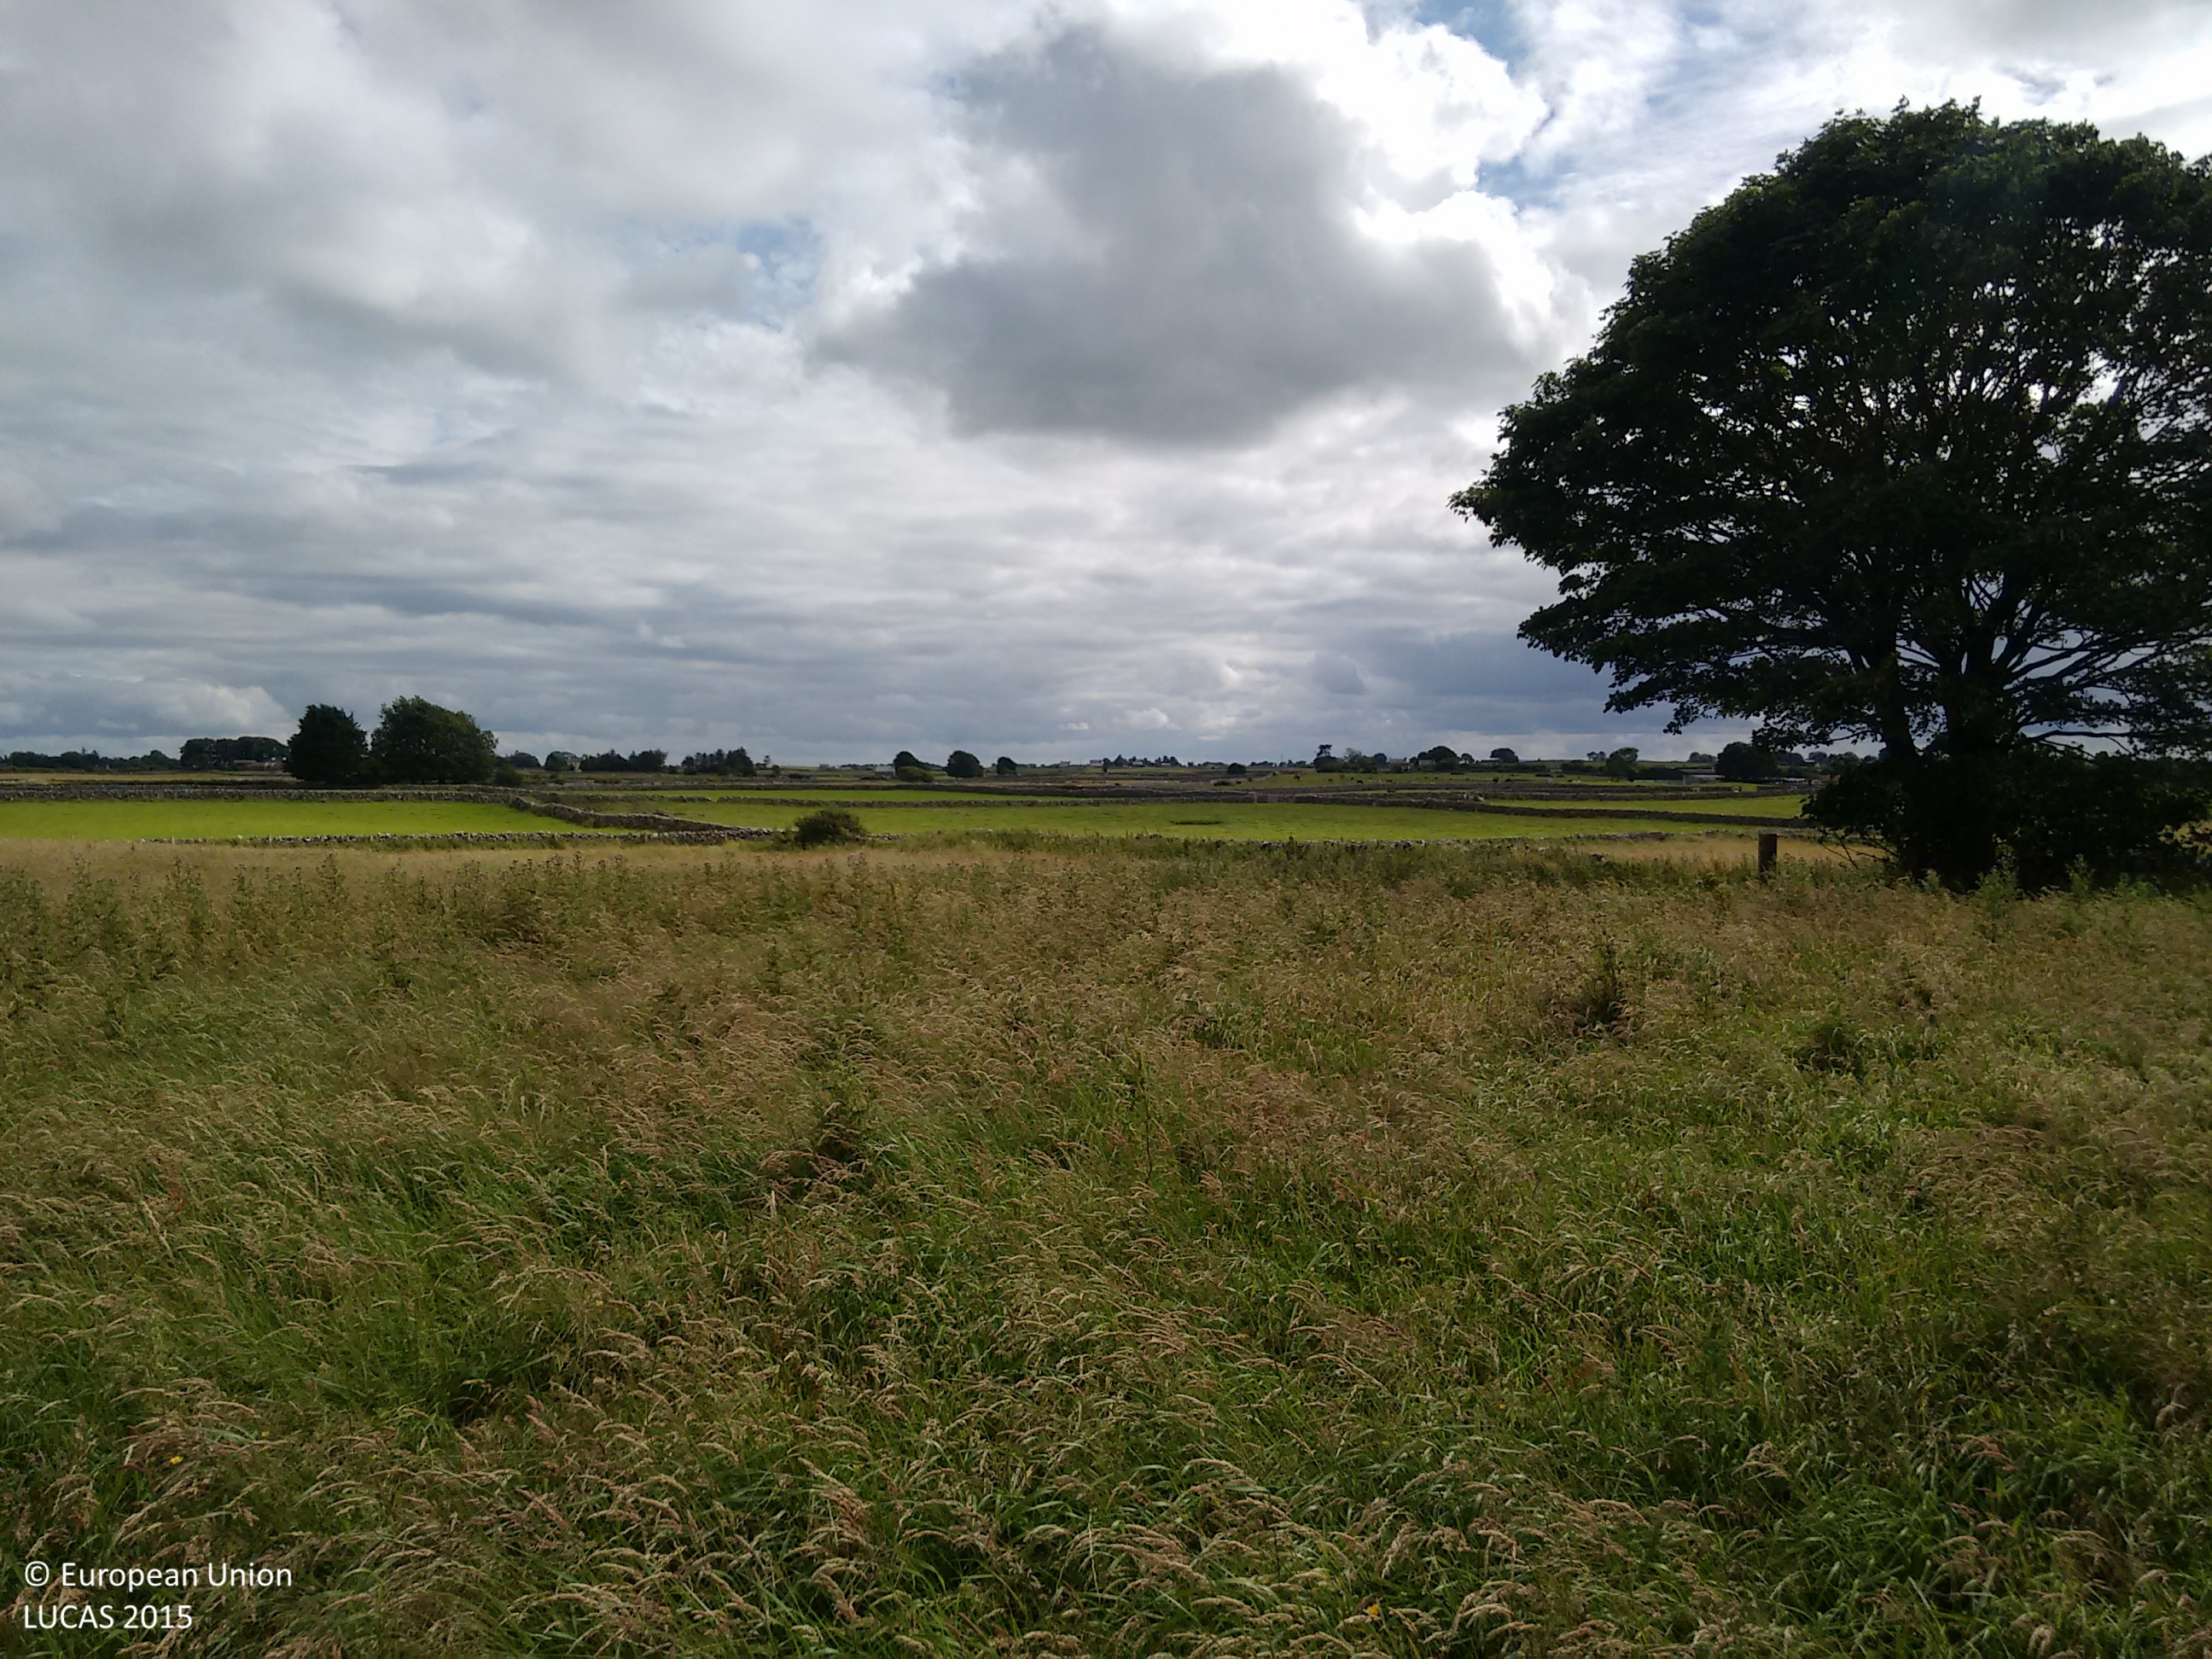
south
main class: Grassland
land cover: Grassland without tree/shrub cover
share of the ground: > 75 %
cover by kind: herbaceous plants 100 %
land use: Agriculture (excluding fallow land and kitchen gardens)
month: July
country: IE
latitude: 53.6146
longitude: -9.1277
